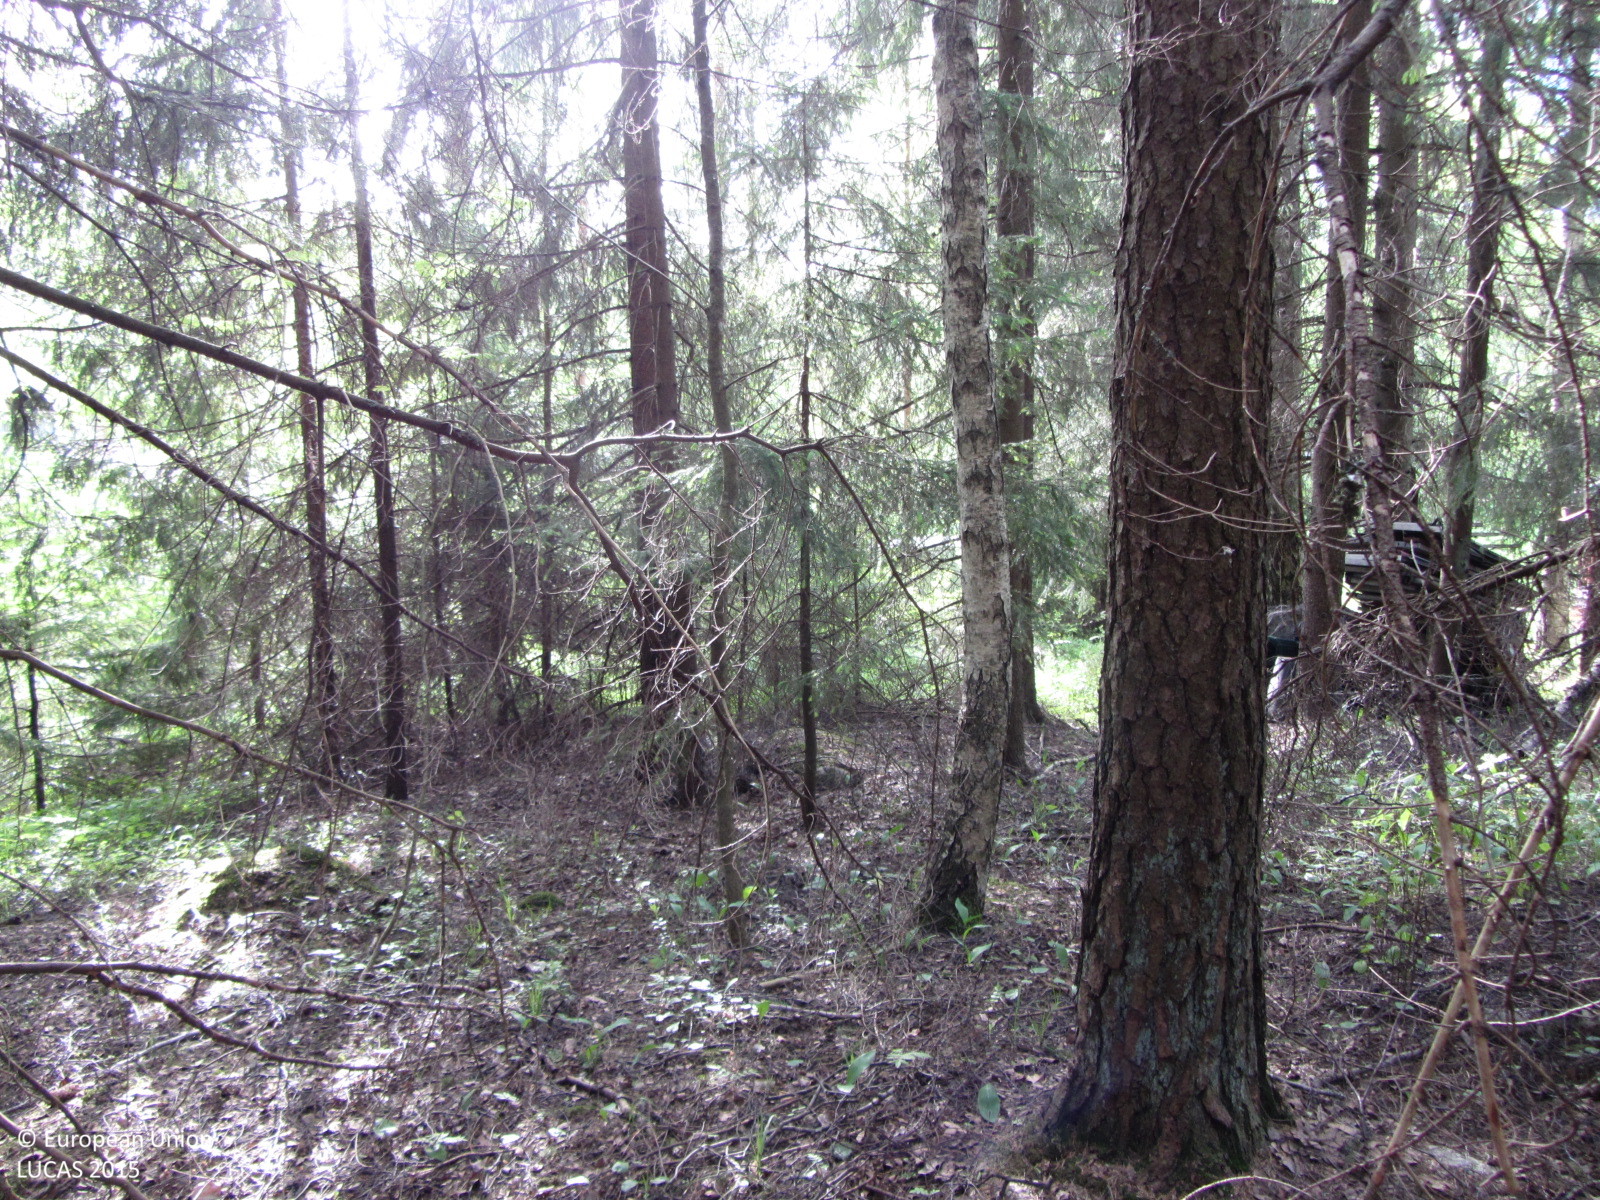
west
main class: Woodland
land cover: Spruce dominated mixed woodland
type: boreal forest
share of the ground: 50 - 75 %
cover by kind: coniferous forest trees 40 %, broadleaved forest trees 20 %, herbaceous plants 20 %, unconsolidated bare surface 20 %
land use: Residential
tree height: > 5 m
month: June
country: FI
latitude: 60.3149
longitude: 24.2402
